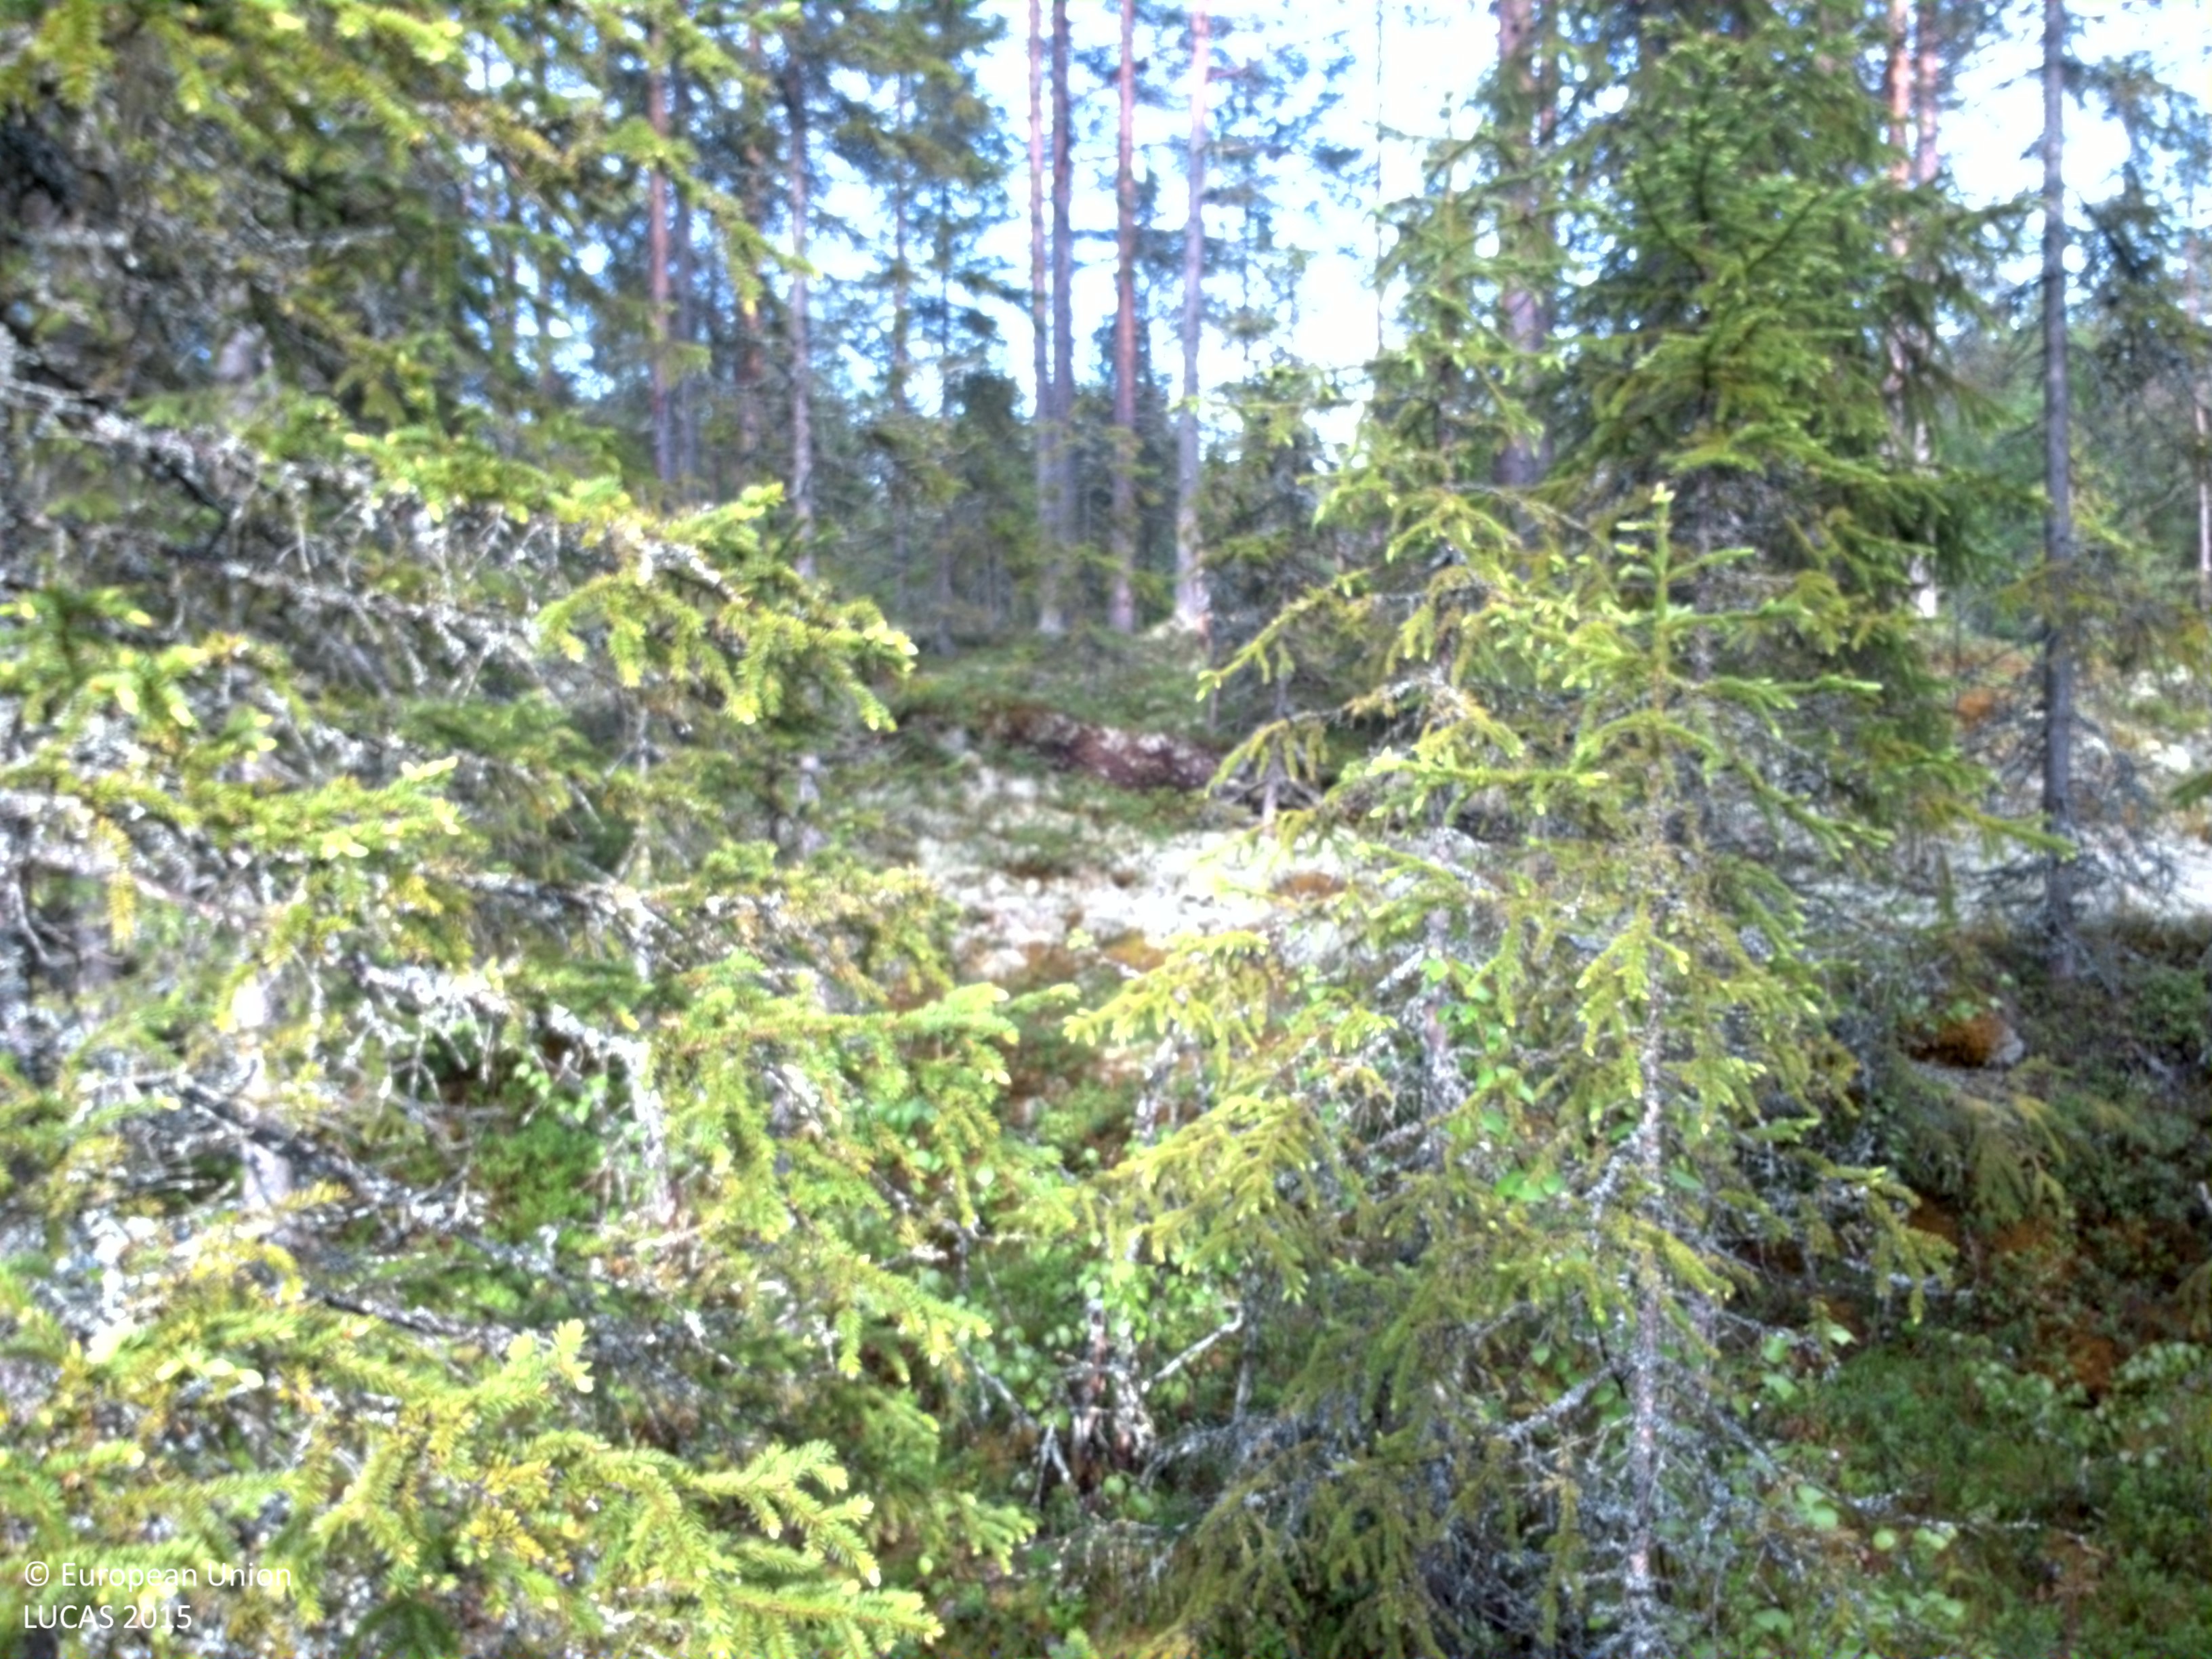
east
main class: Woodland
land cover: Other coniferous woodland
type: boreal forest
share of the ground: 25 - 50 %
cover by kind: coniferous forest trees 40 %, lichens and mosses 30 %, broadleaved forest trees 10 %, shrubs 10 %, herbaceous plants 10 %
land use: Forestry
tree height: > 5 m
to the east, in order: Other coniferous woodland; Spruce dominated mixed woodland; Rivers and streams; Spruce dominated mixed woodland; Broadleaved woodland; Rivers and streams; Broadleaved woodland; Spruce dominated mixed woodland; Rivers and streams; Broadleaved woodland
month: June
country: SE
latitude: 61.4559
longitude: 13.3833
